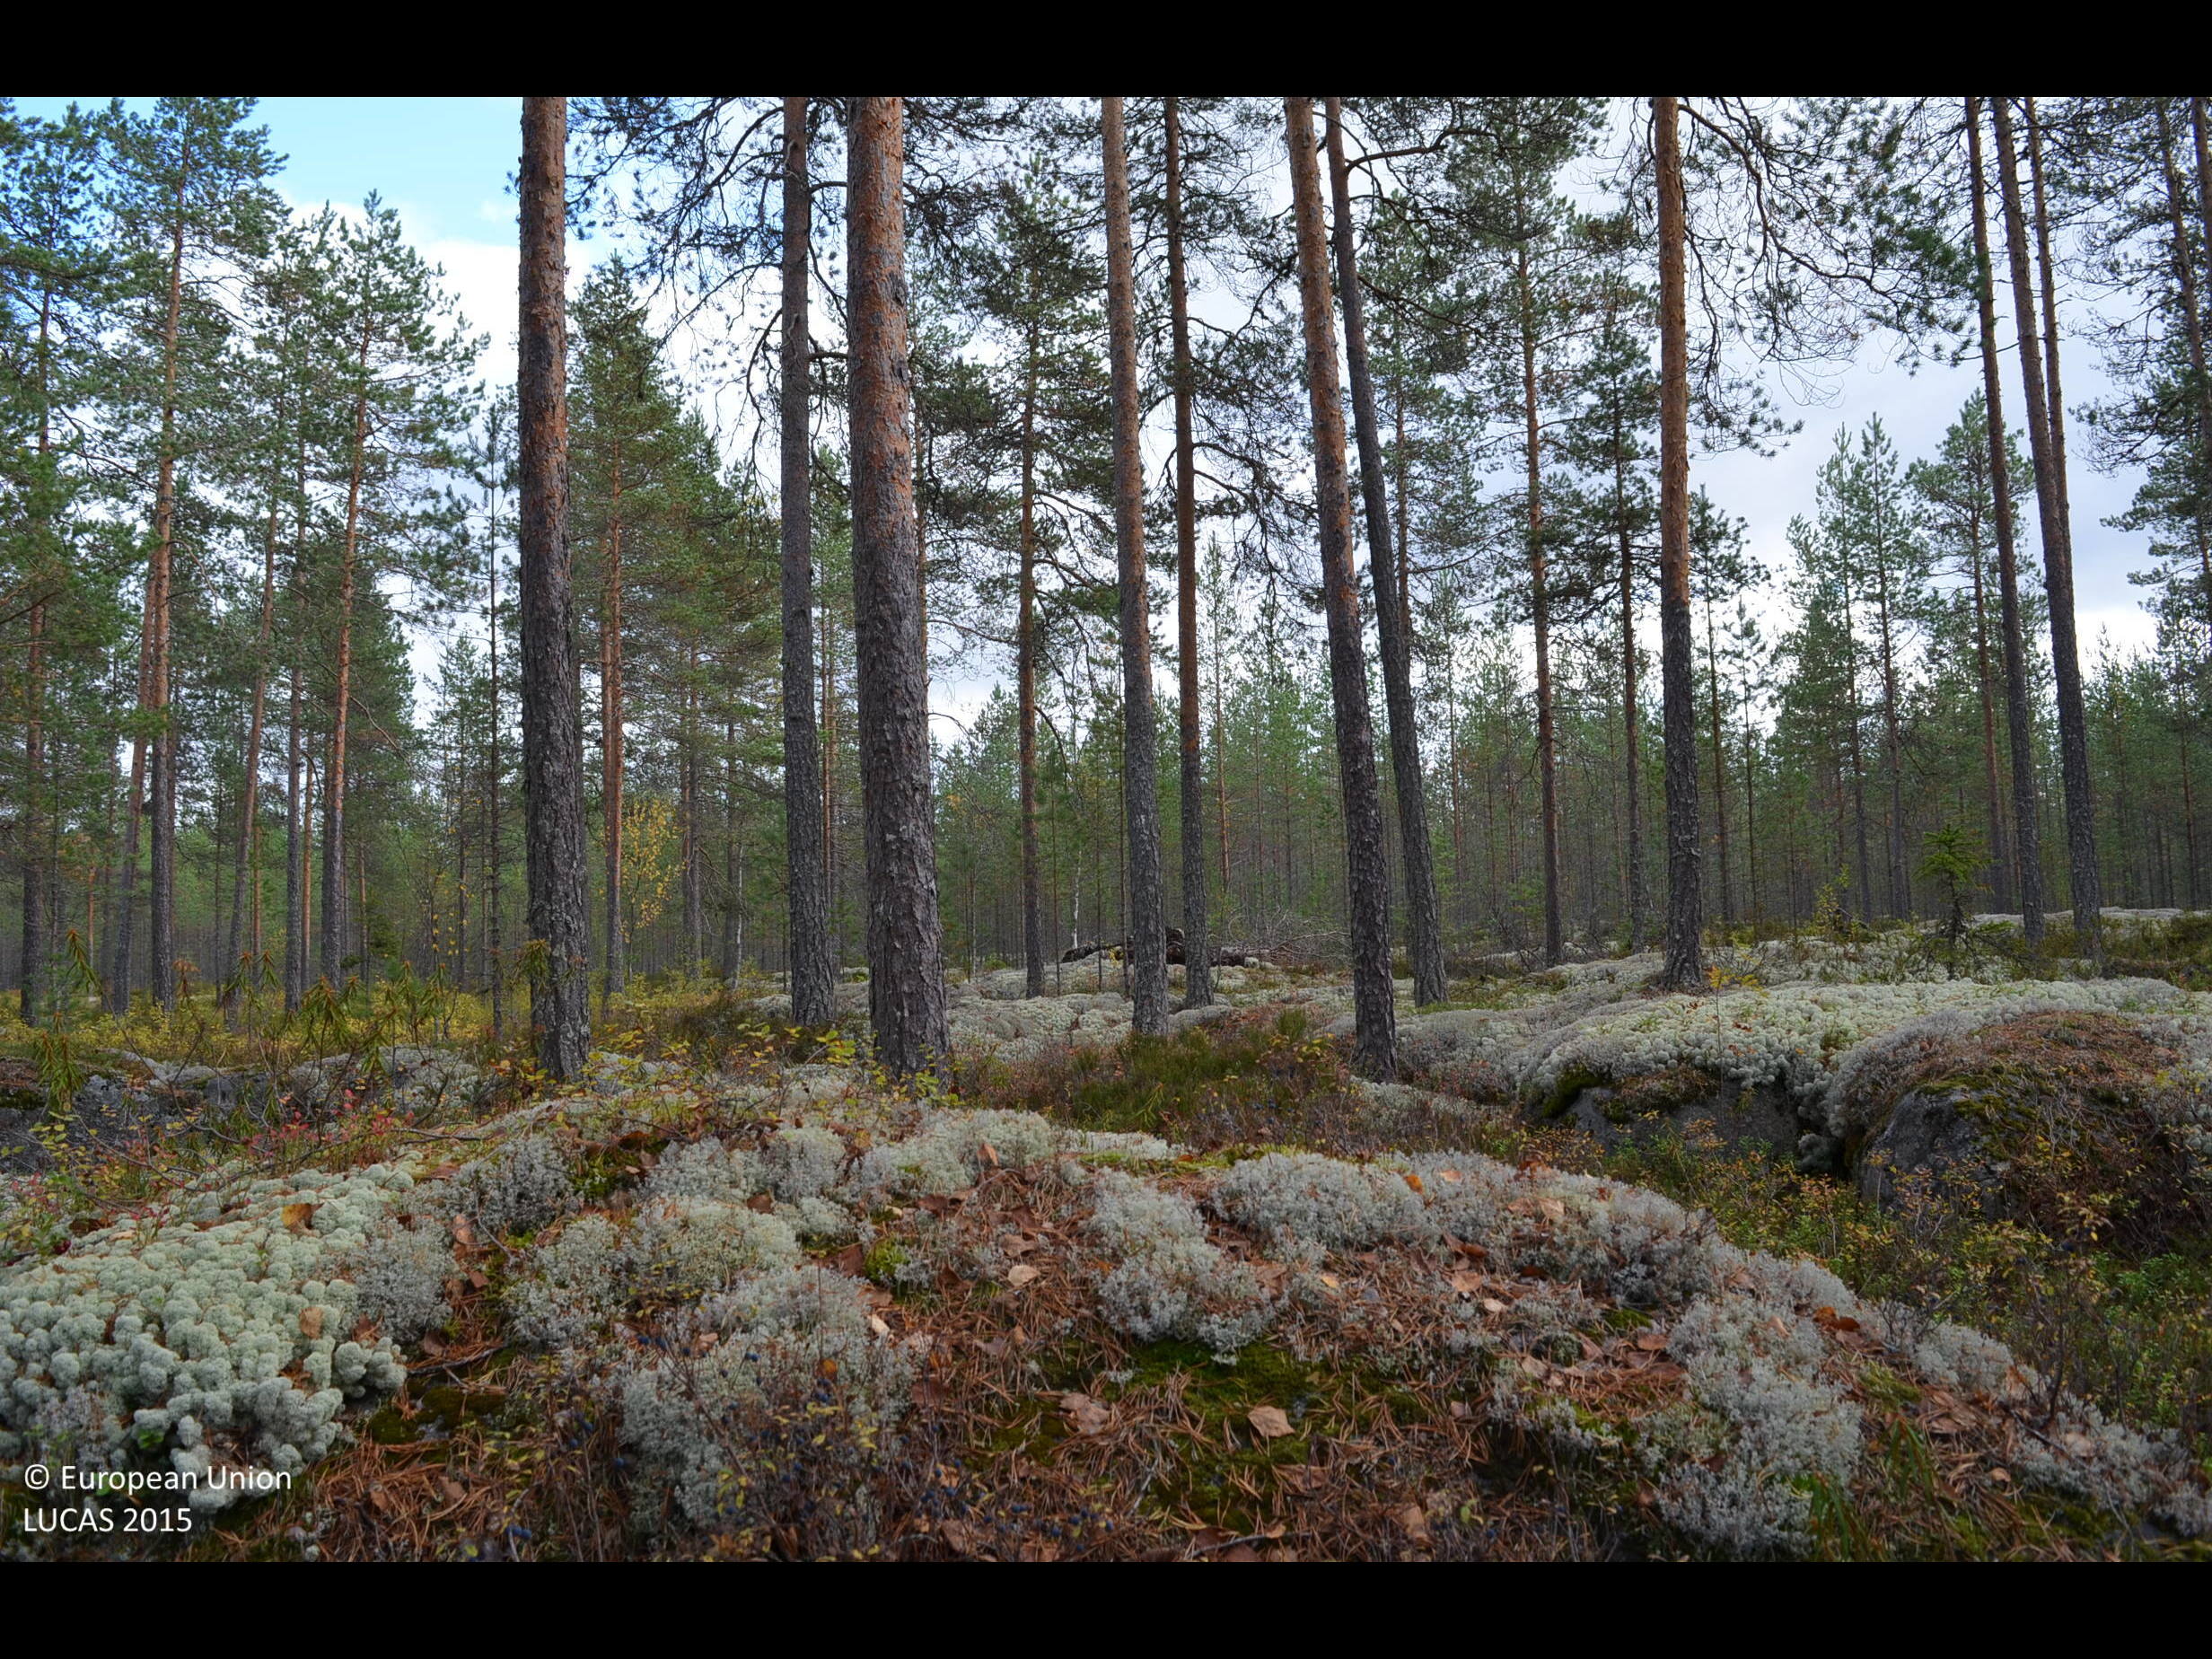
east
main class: Woodland
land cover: Pine dominated coniferous woodland
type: boreal forest
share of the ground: 50 - 75 %
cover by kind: coniferous forest trees 55 %, shrubs 25 %, unconsolidated bare surface 15 %, broadleaved forest trees 5 %
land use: Forestry
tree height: > 5 m
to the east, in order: Pine dominated coniferous woodland; Other coniferous woodland; Pine dominated mixed woodland
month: September
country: FI
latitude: 62.5259
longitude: 23.5756
